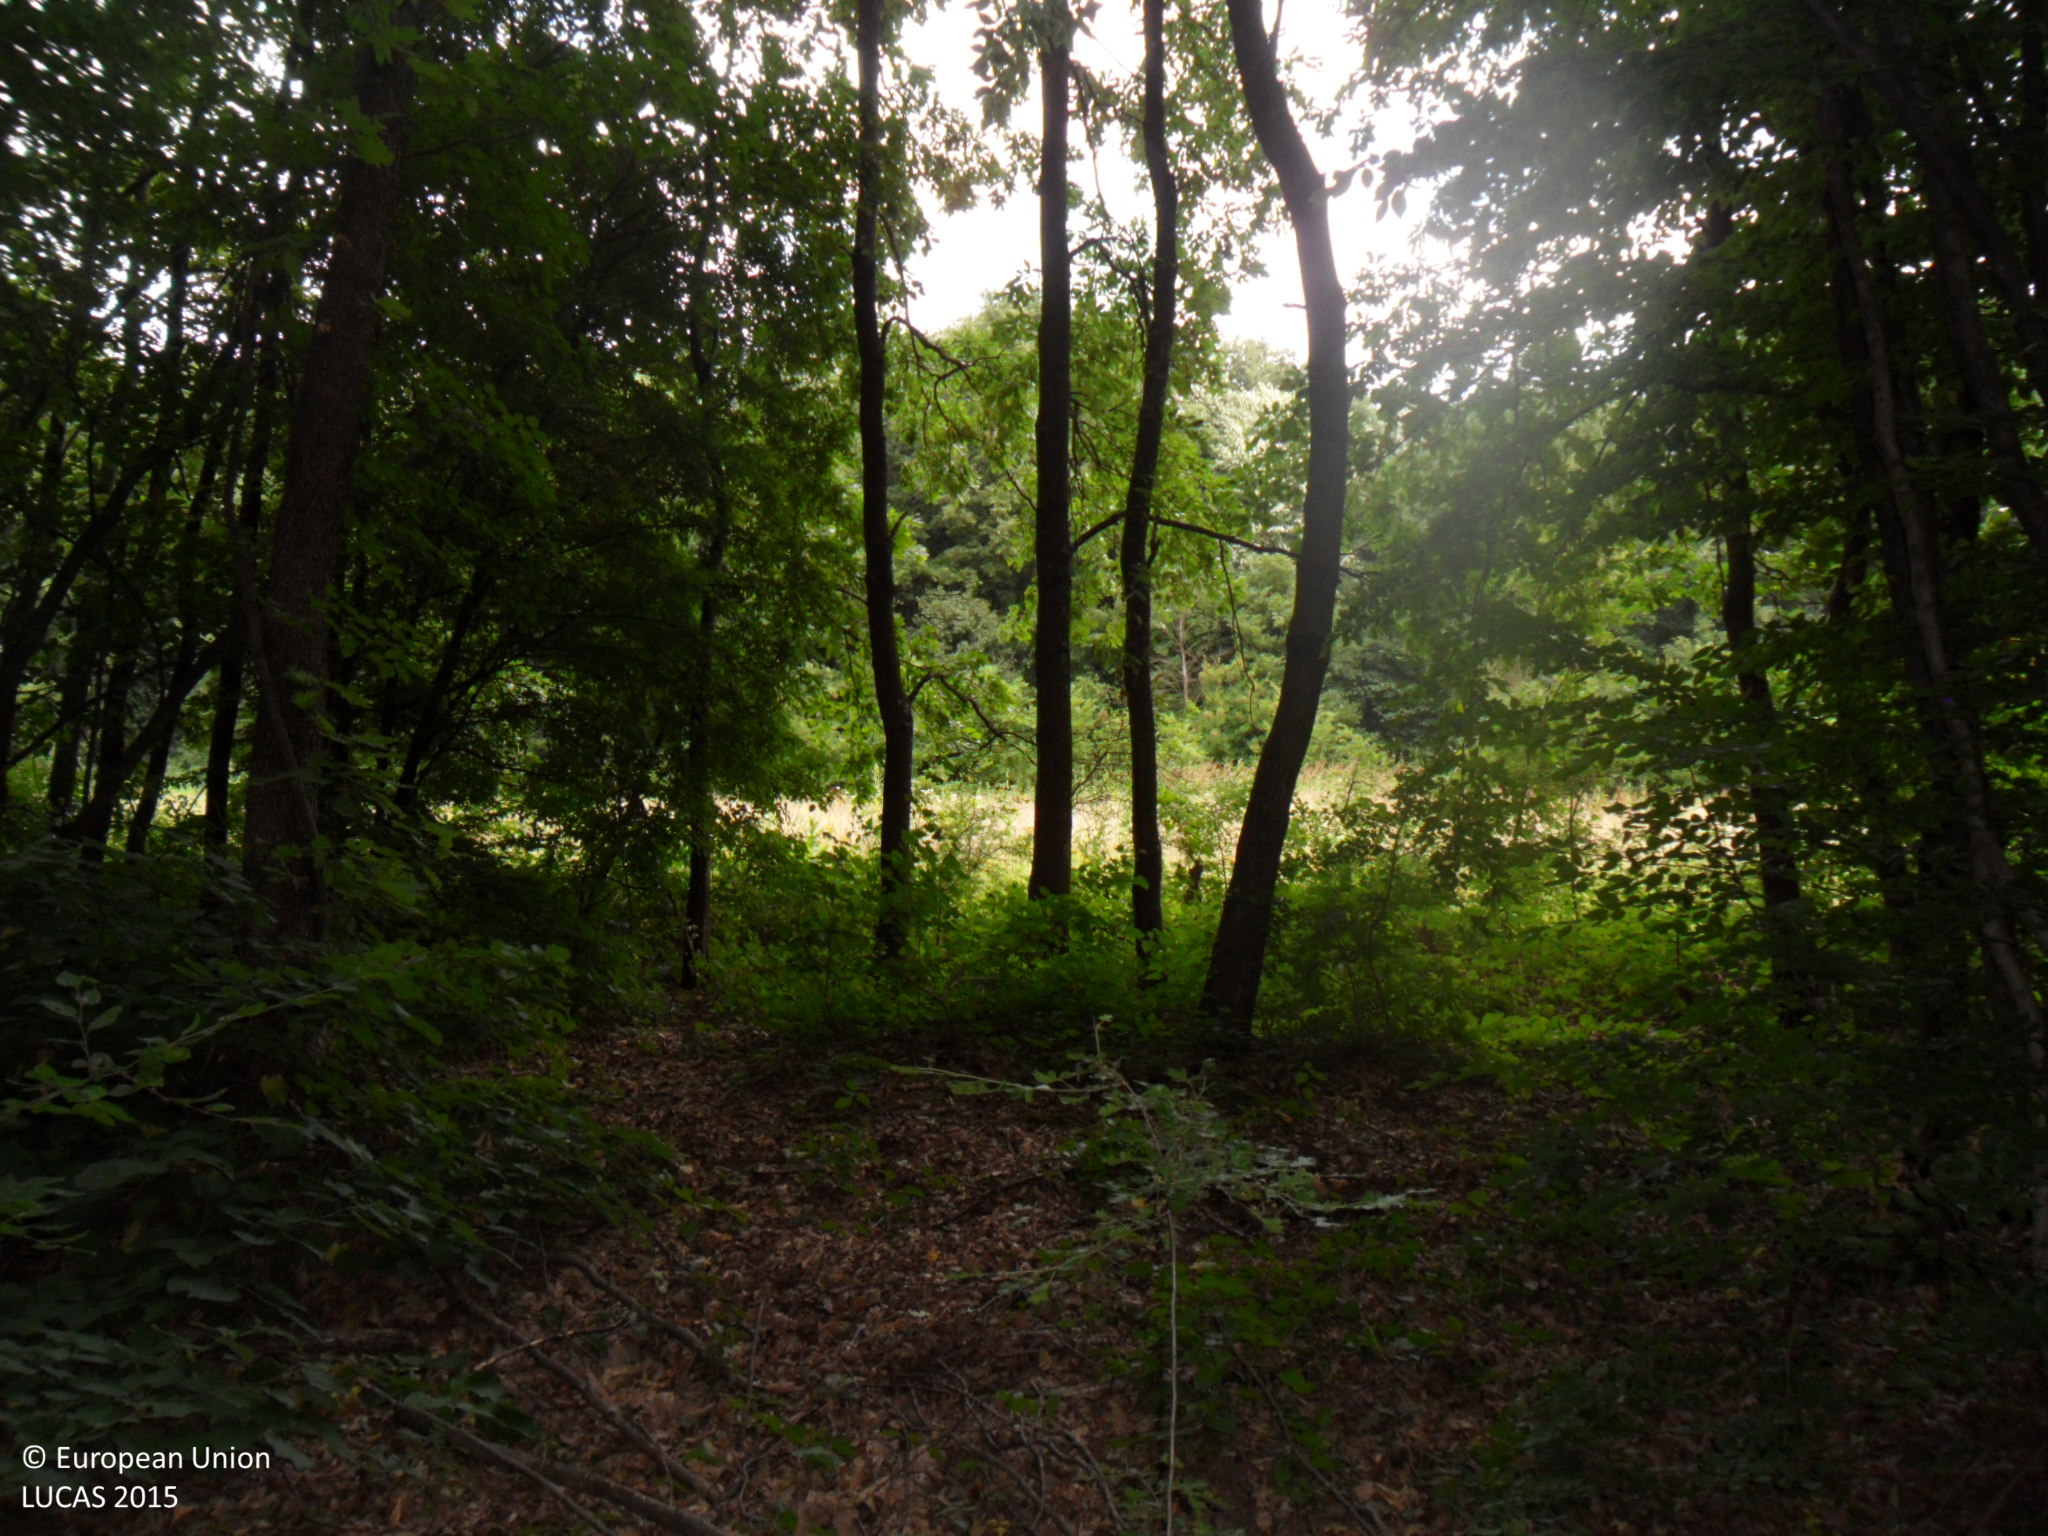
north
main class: Woodland
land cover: Broadleaved woodland
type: mesophytic deciduous forest
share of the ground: > 75 %
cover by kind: broadleaved forest trees 100 %
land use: Forestry
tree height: > 5 m
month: June
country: BG
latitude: 43.1335
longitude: 26.9157
